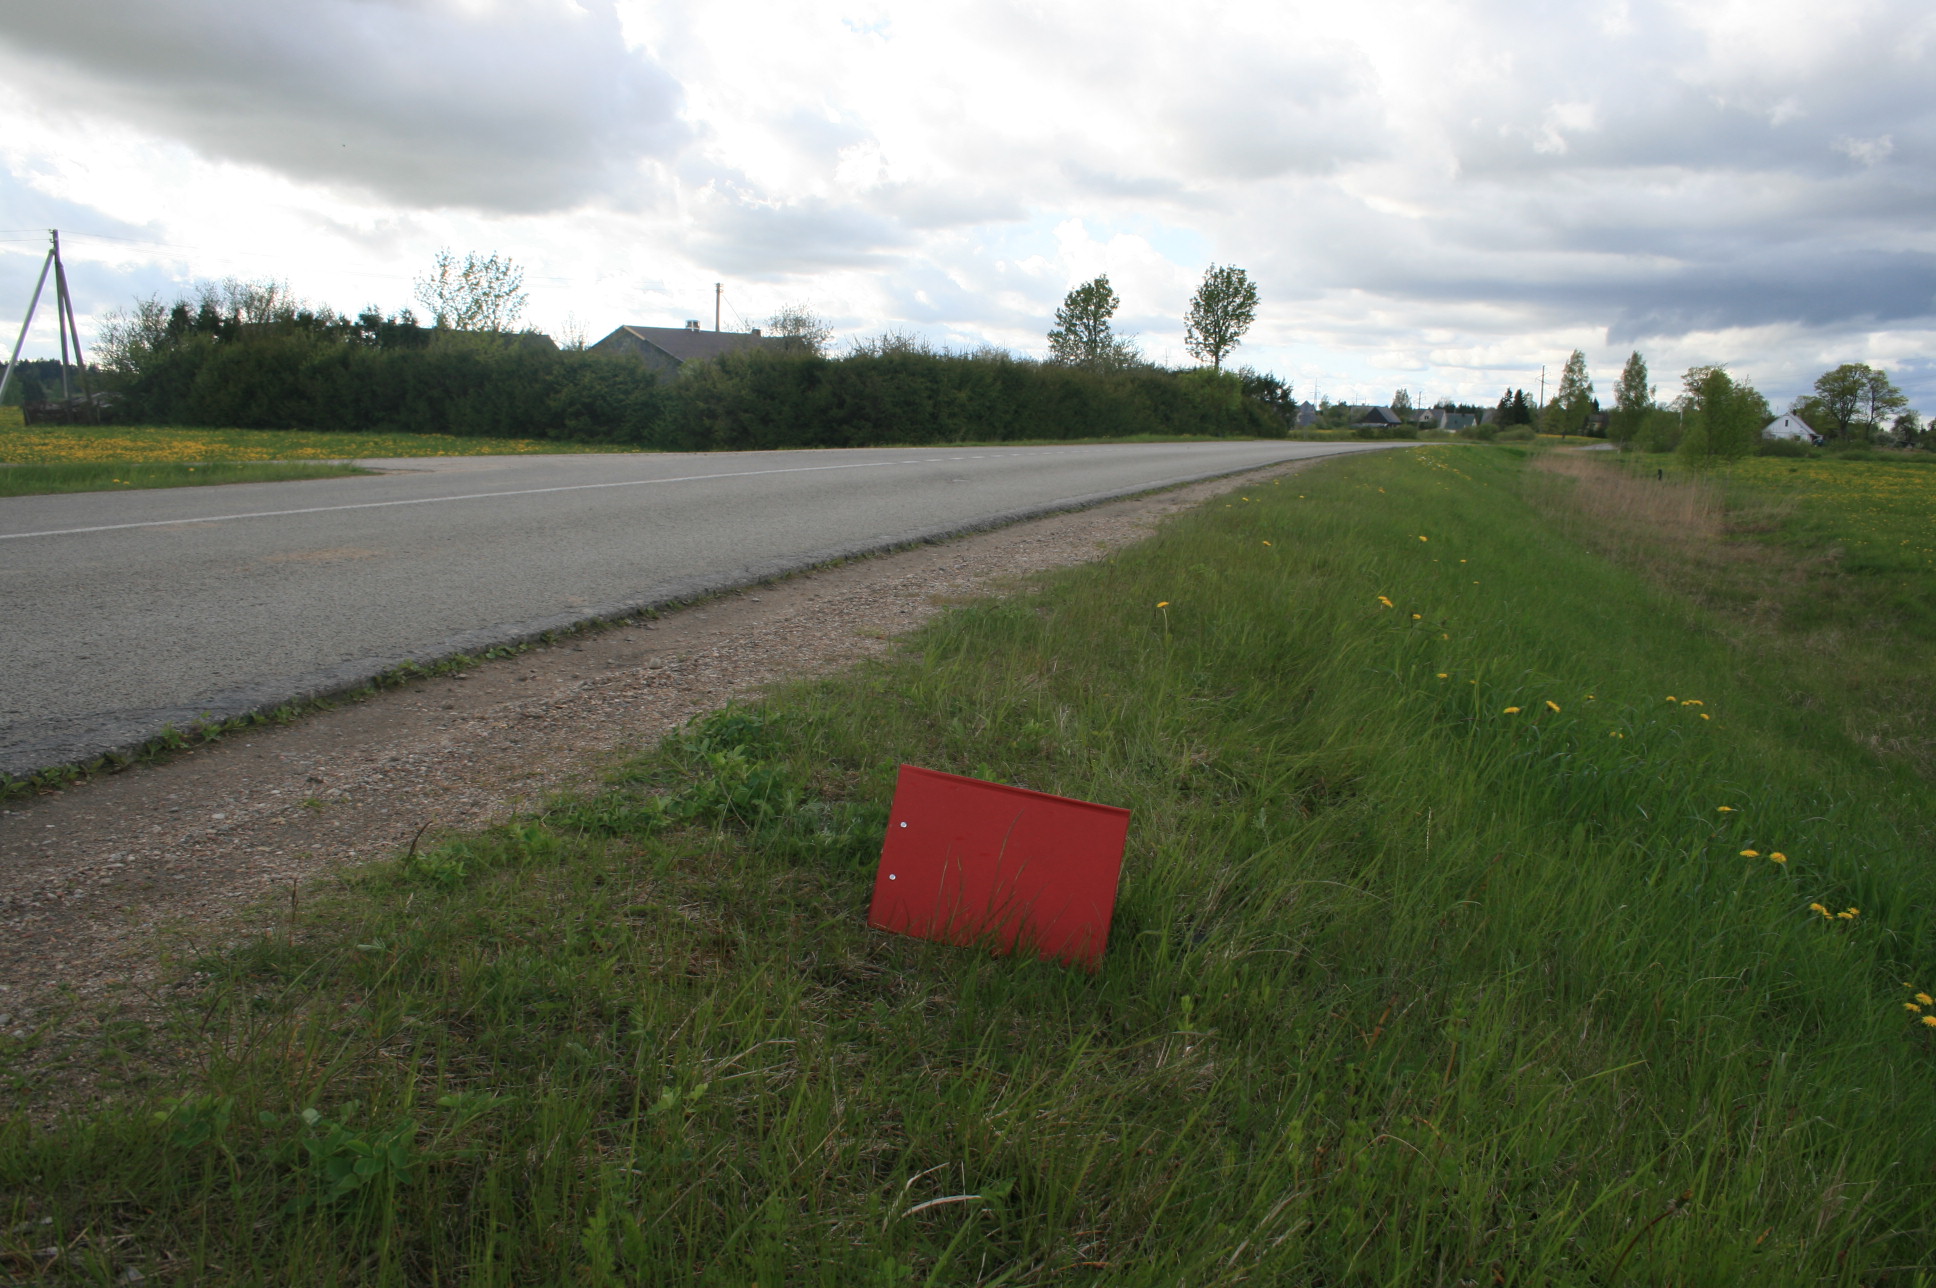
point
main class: Grassland
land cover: Grassland without tree/shrub cover
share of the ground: > 75 %
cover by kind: herbaceous plants 100 %
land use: Agriculture (excluding fallow land and kitchen gardens)
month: May
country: LT
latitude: 56.1606
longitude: 22.0799
